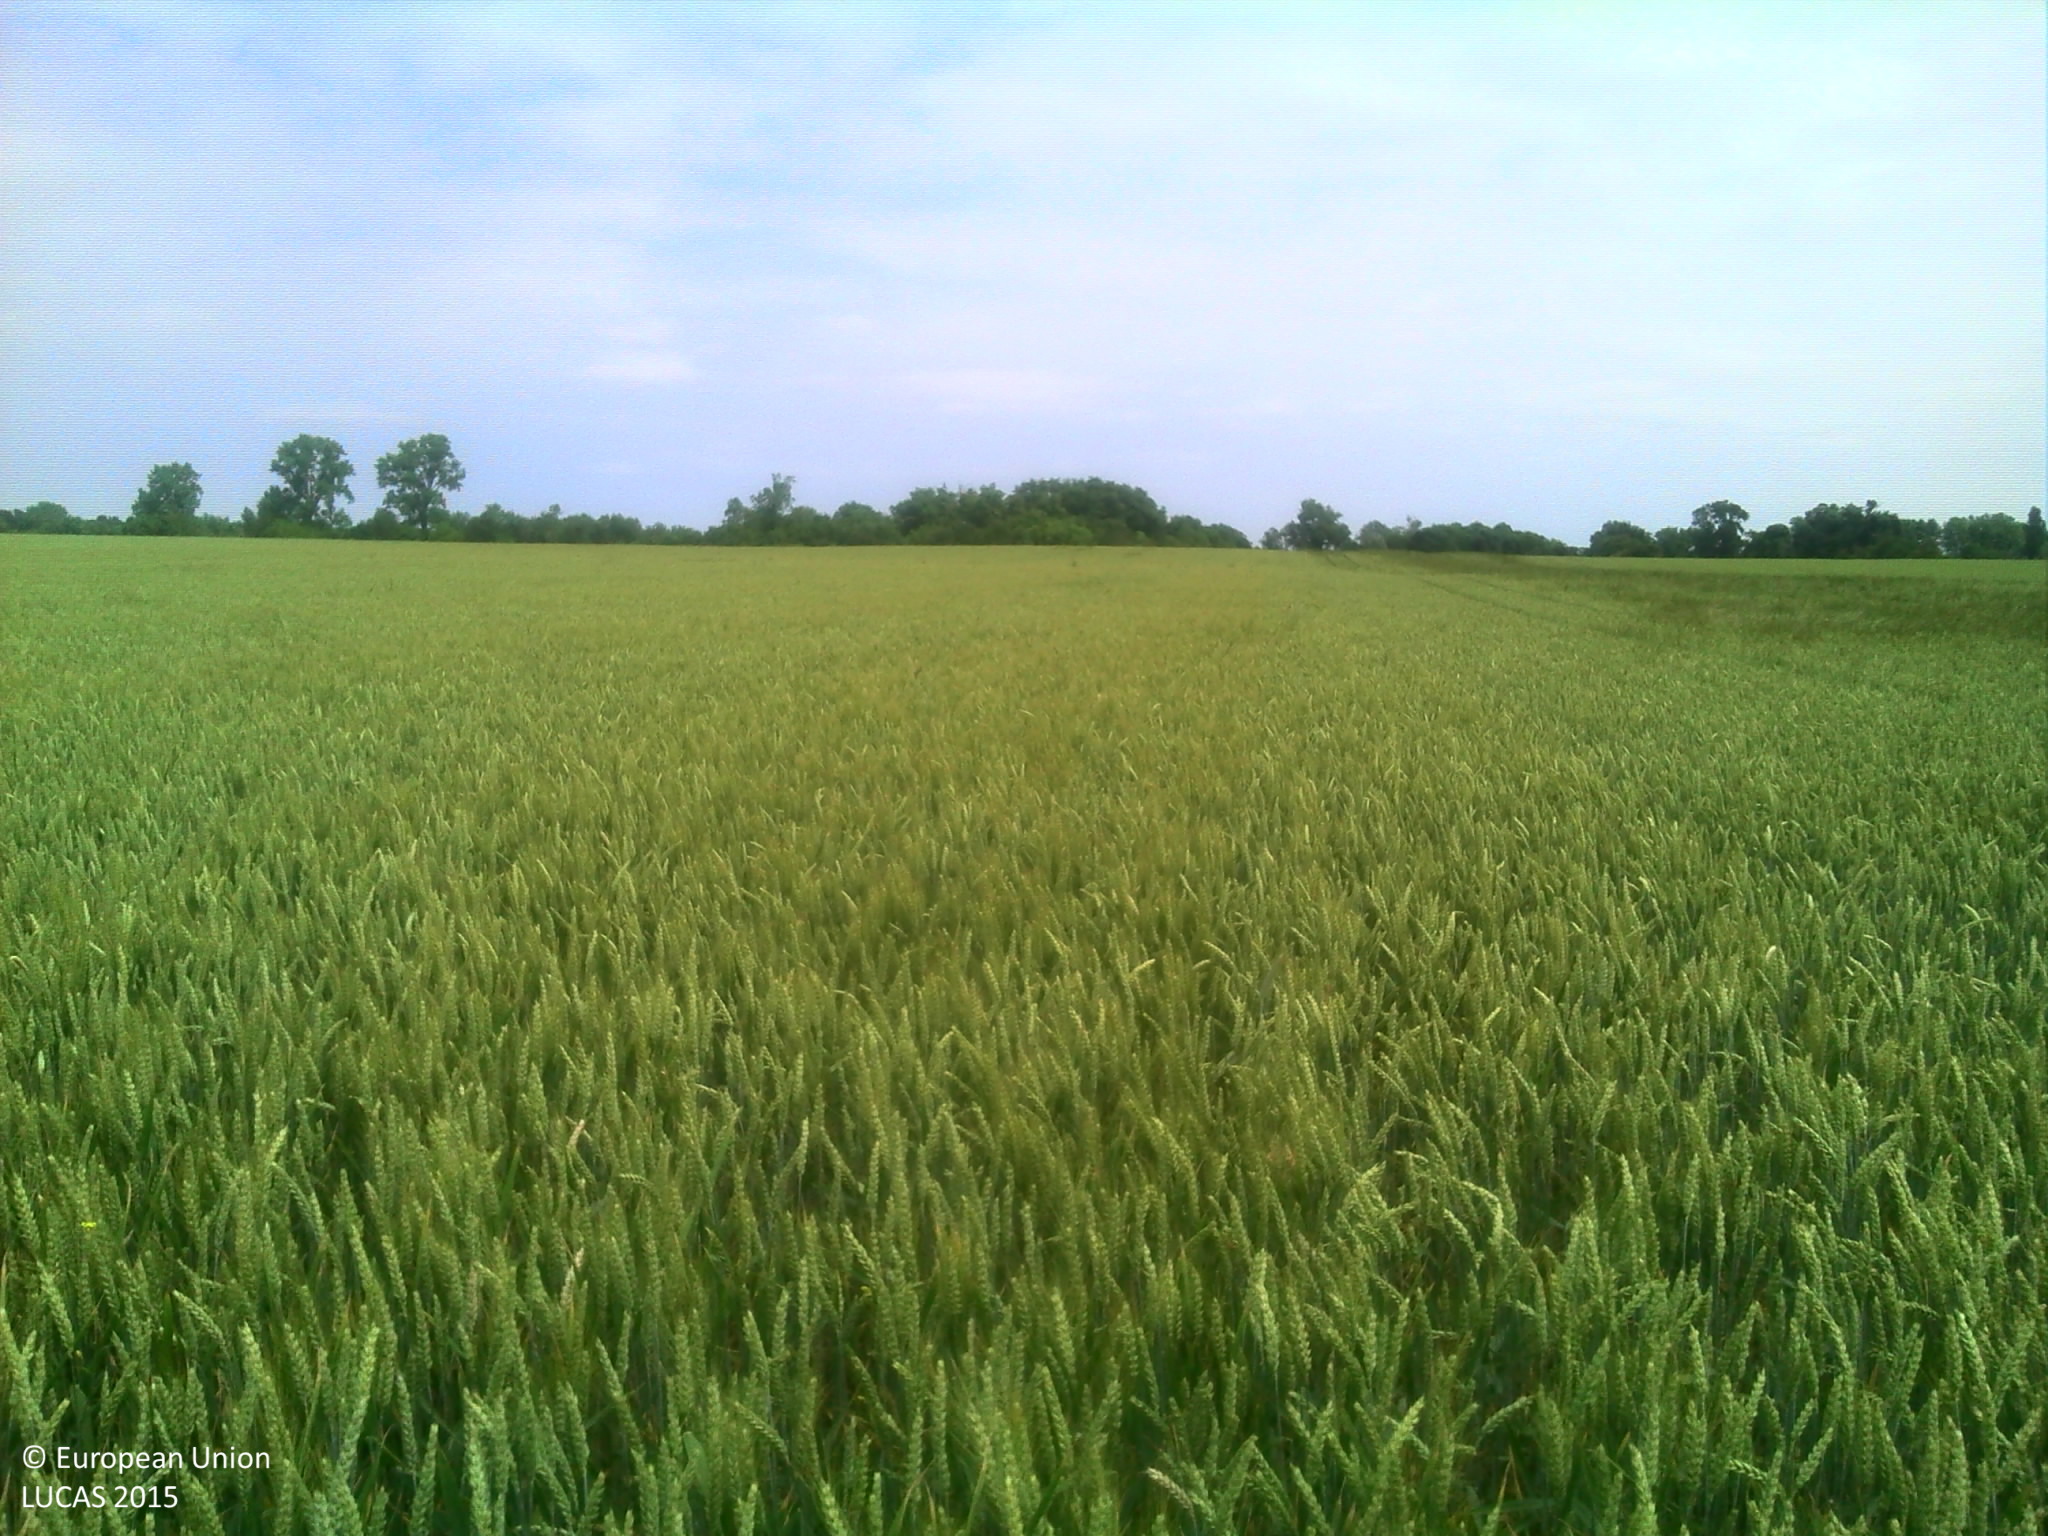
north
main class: Cropland
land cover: Common wheat
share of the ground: > 75 %
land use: Agriculture (excluding fallow land and kitchen gardens)
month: June
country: FR
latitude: 46.1690
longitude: -0.9481
